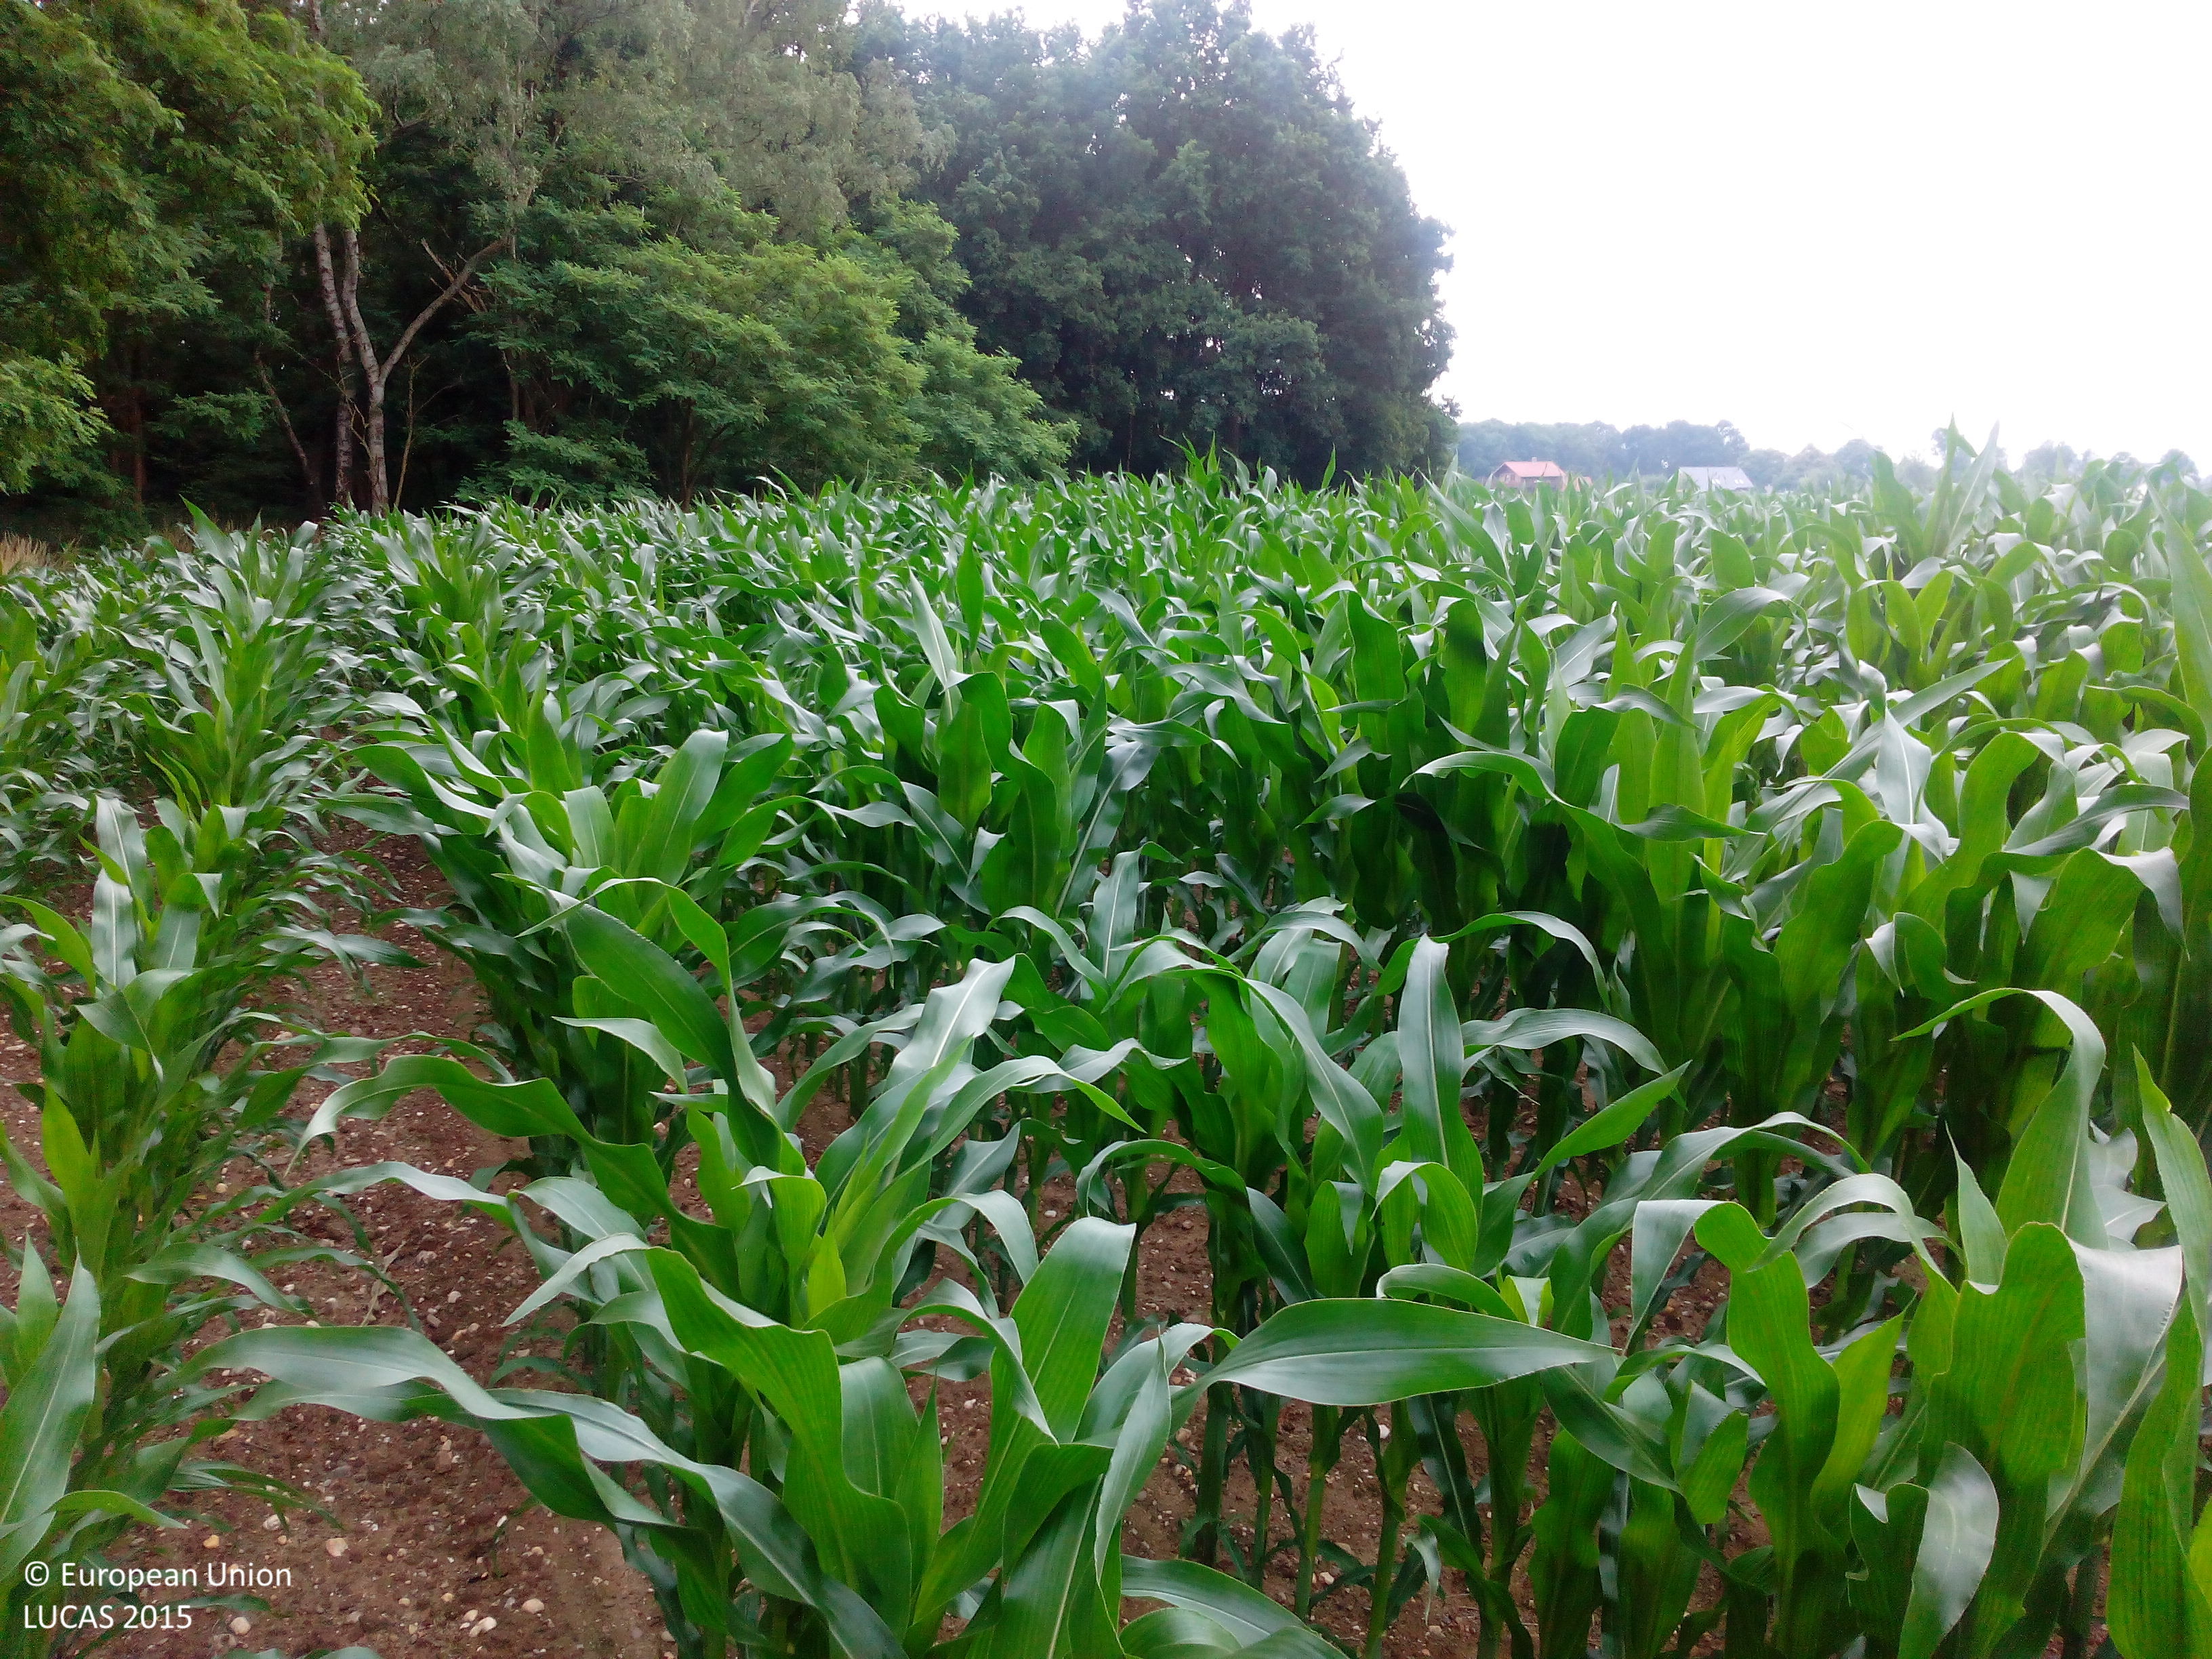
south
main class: Cropland
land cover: Maize
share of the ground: > 75 %
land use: Agriculture (excluding fallow land and kitchen gardens)
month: July
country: NL
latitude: 51.8860
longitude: 6.2364
